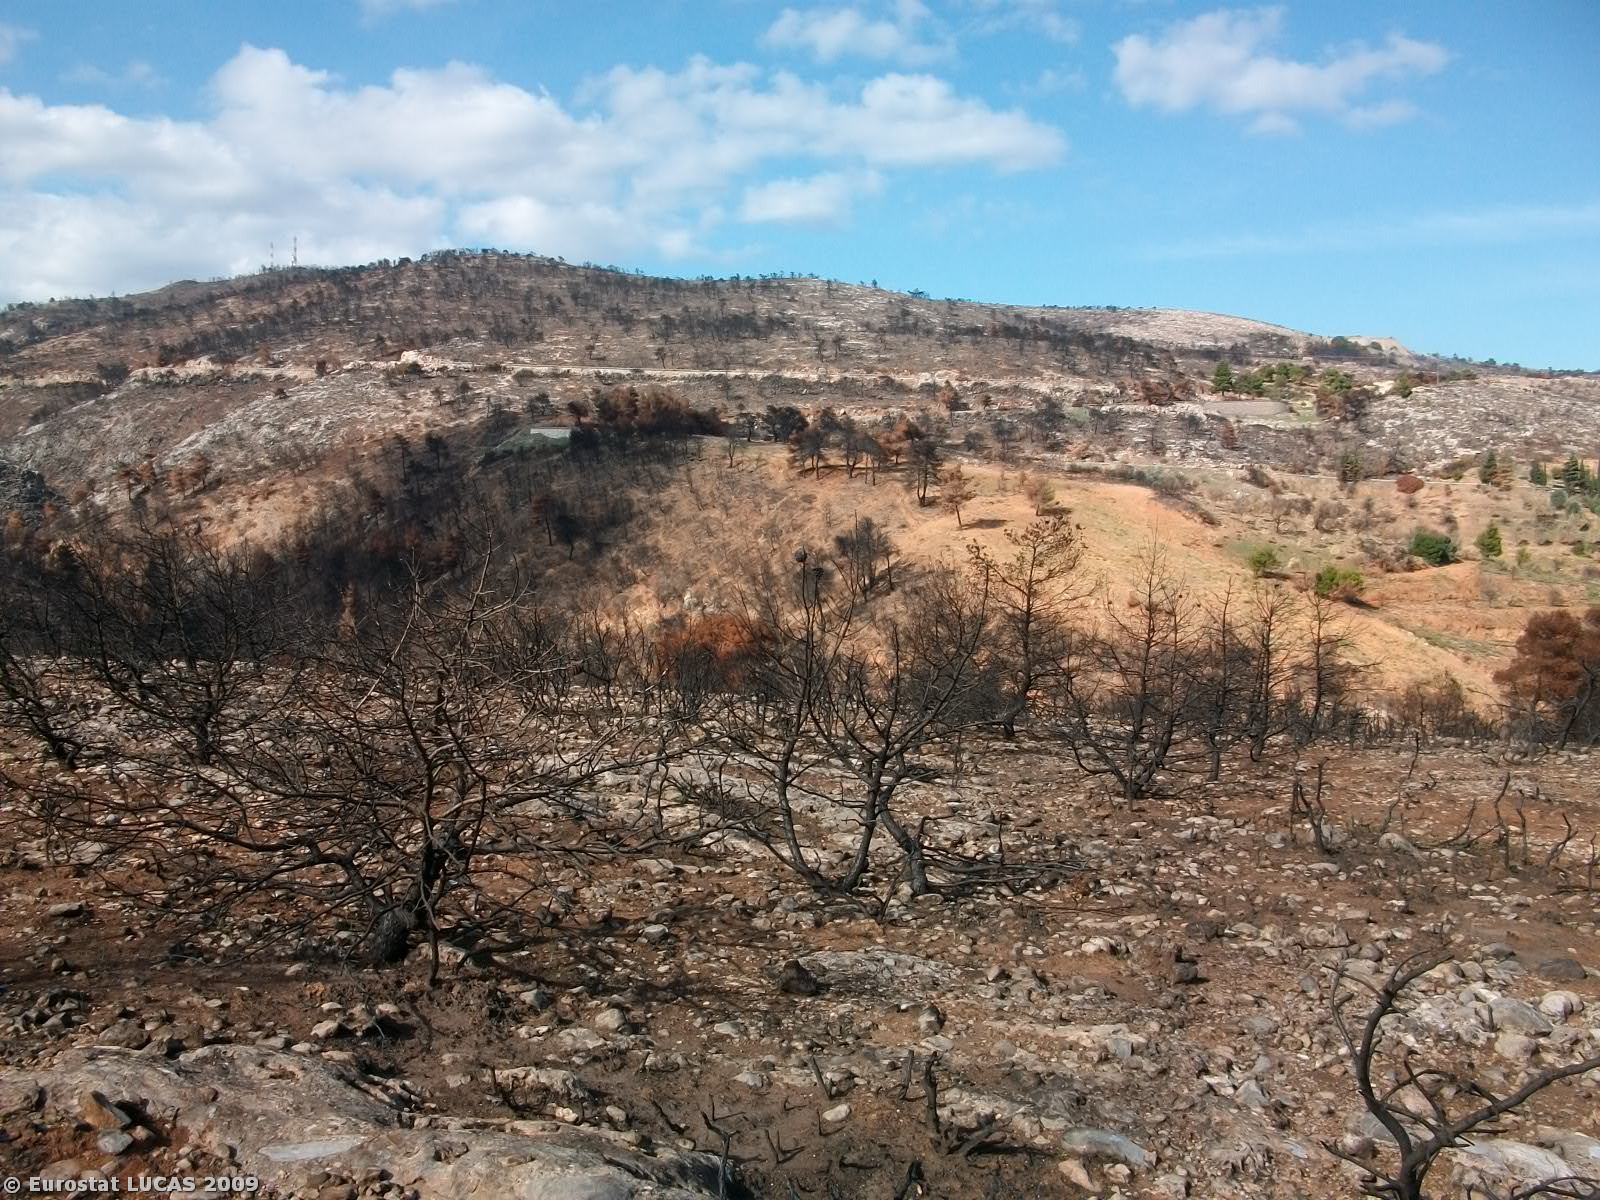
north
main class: Grassland
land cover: Grassland with sparse tree/shrub cover
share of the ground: 10 - 25 %
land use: Unused
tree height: < 5 m
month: September
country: GR
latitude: 38.2011
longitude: 23.9520
